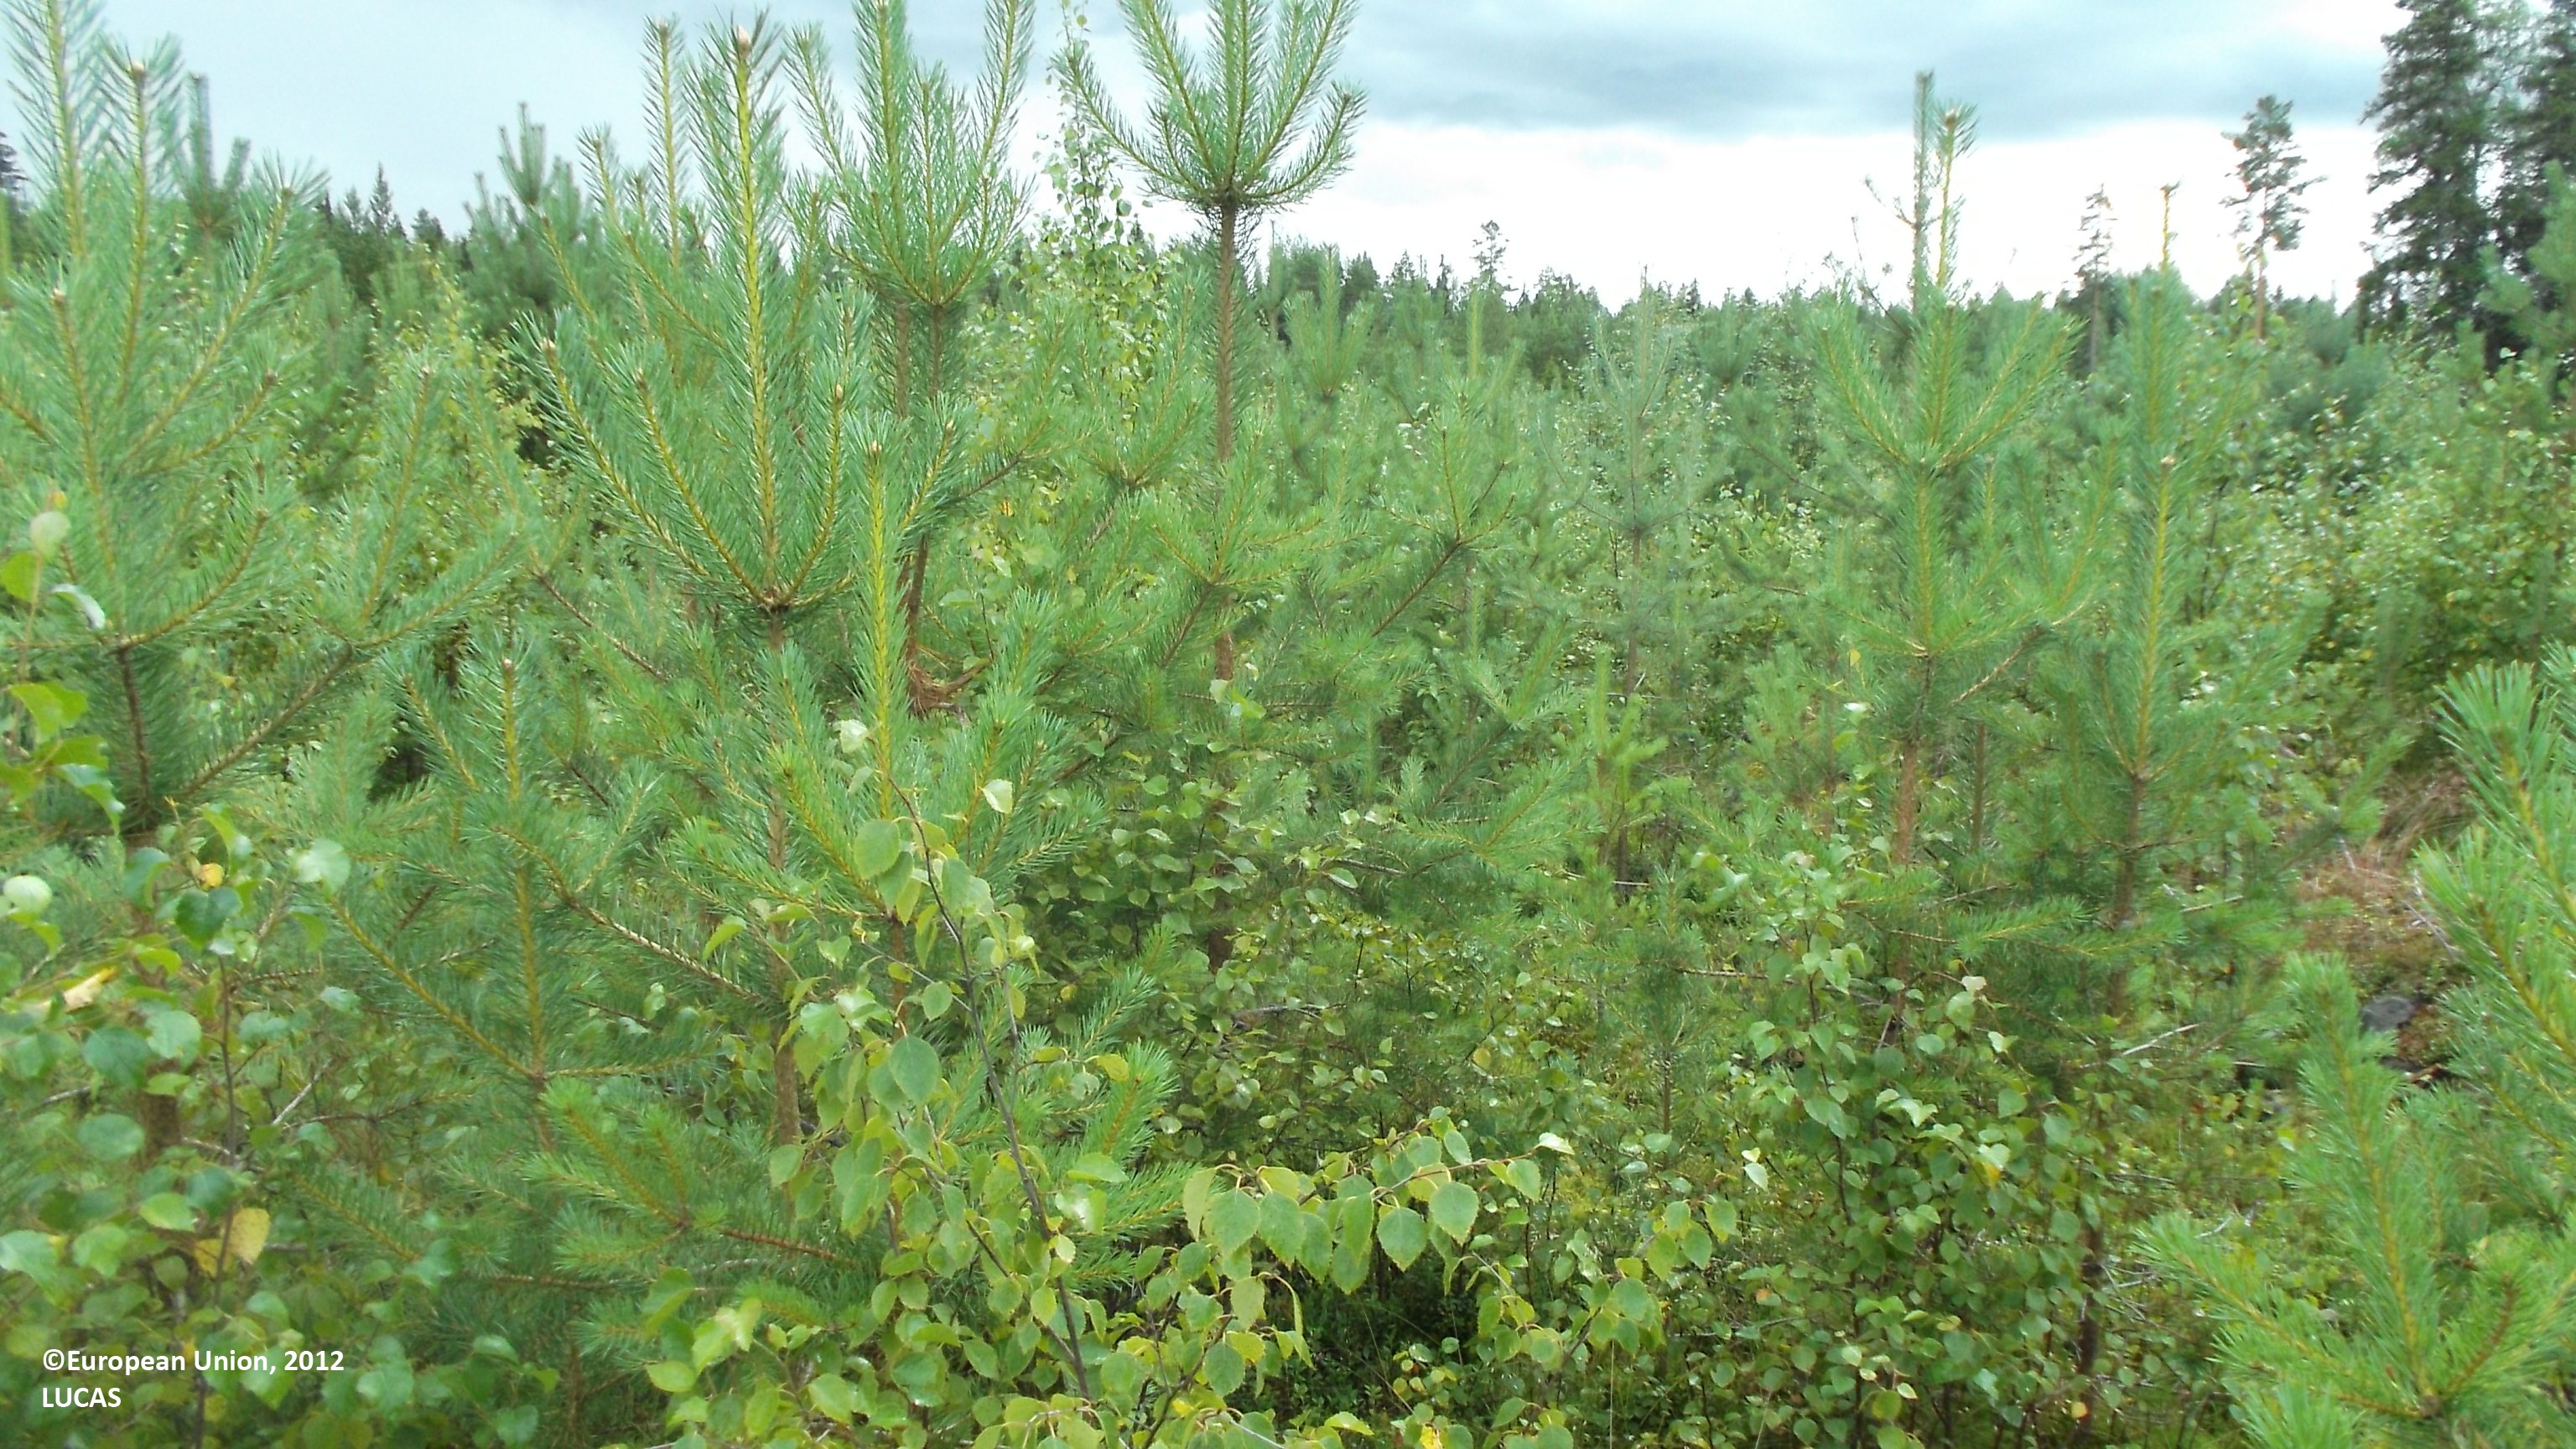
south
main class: Woodland
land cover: Other mixed woodland
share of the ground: 25 - 50 %
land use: Forestry
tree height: < 5 m
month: August
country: FI
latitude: 63.9216
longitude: 23.5768
